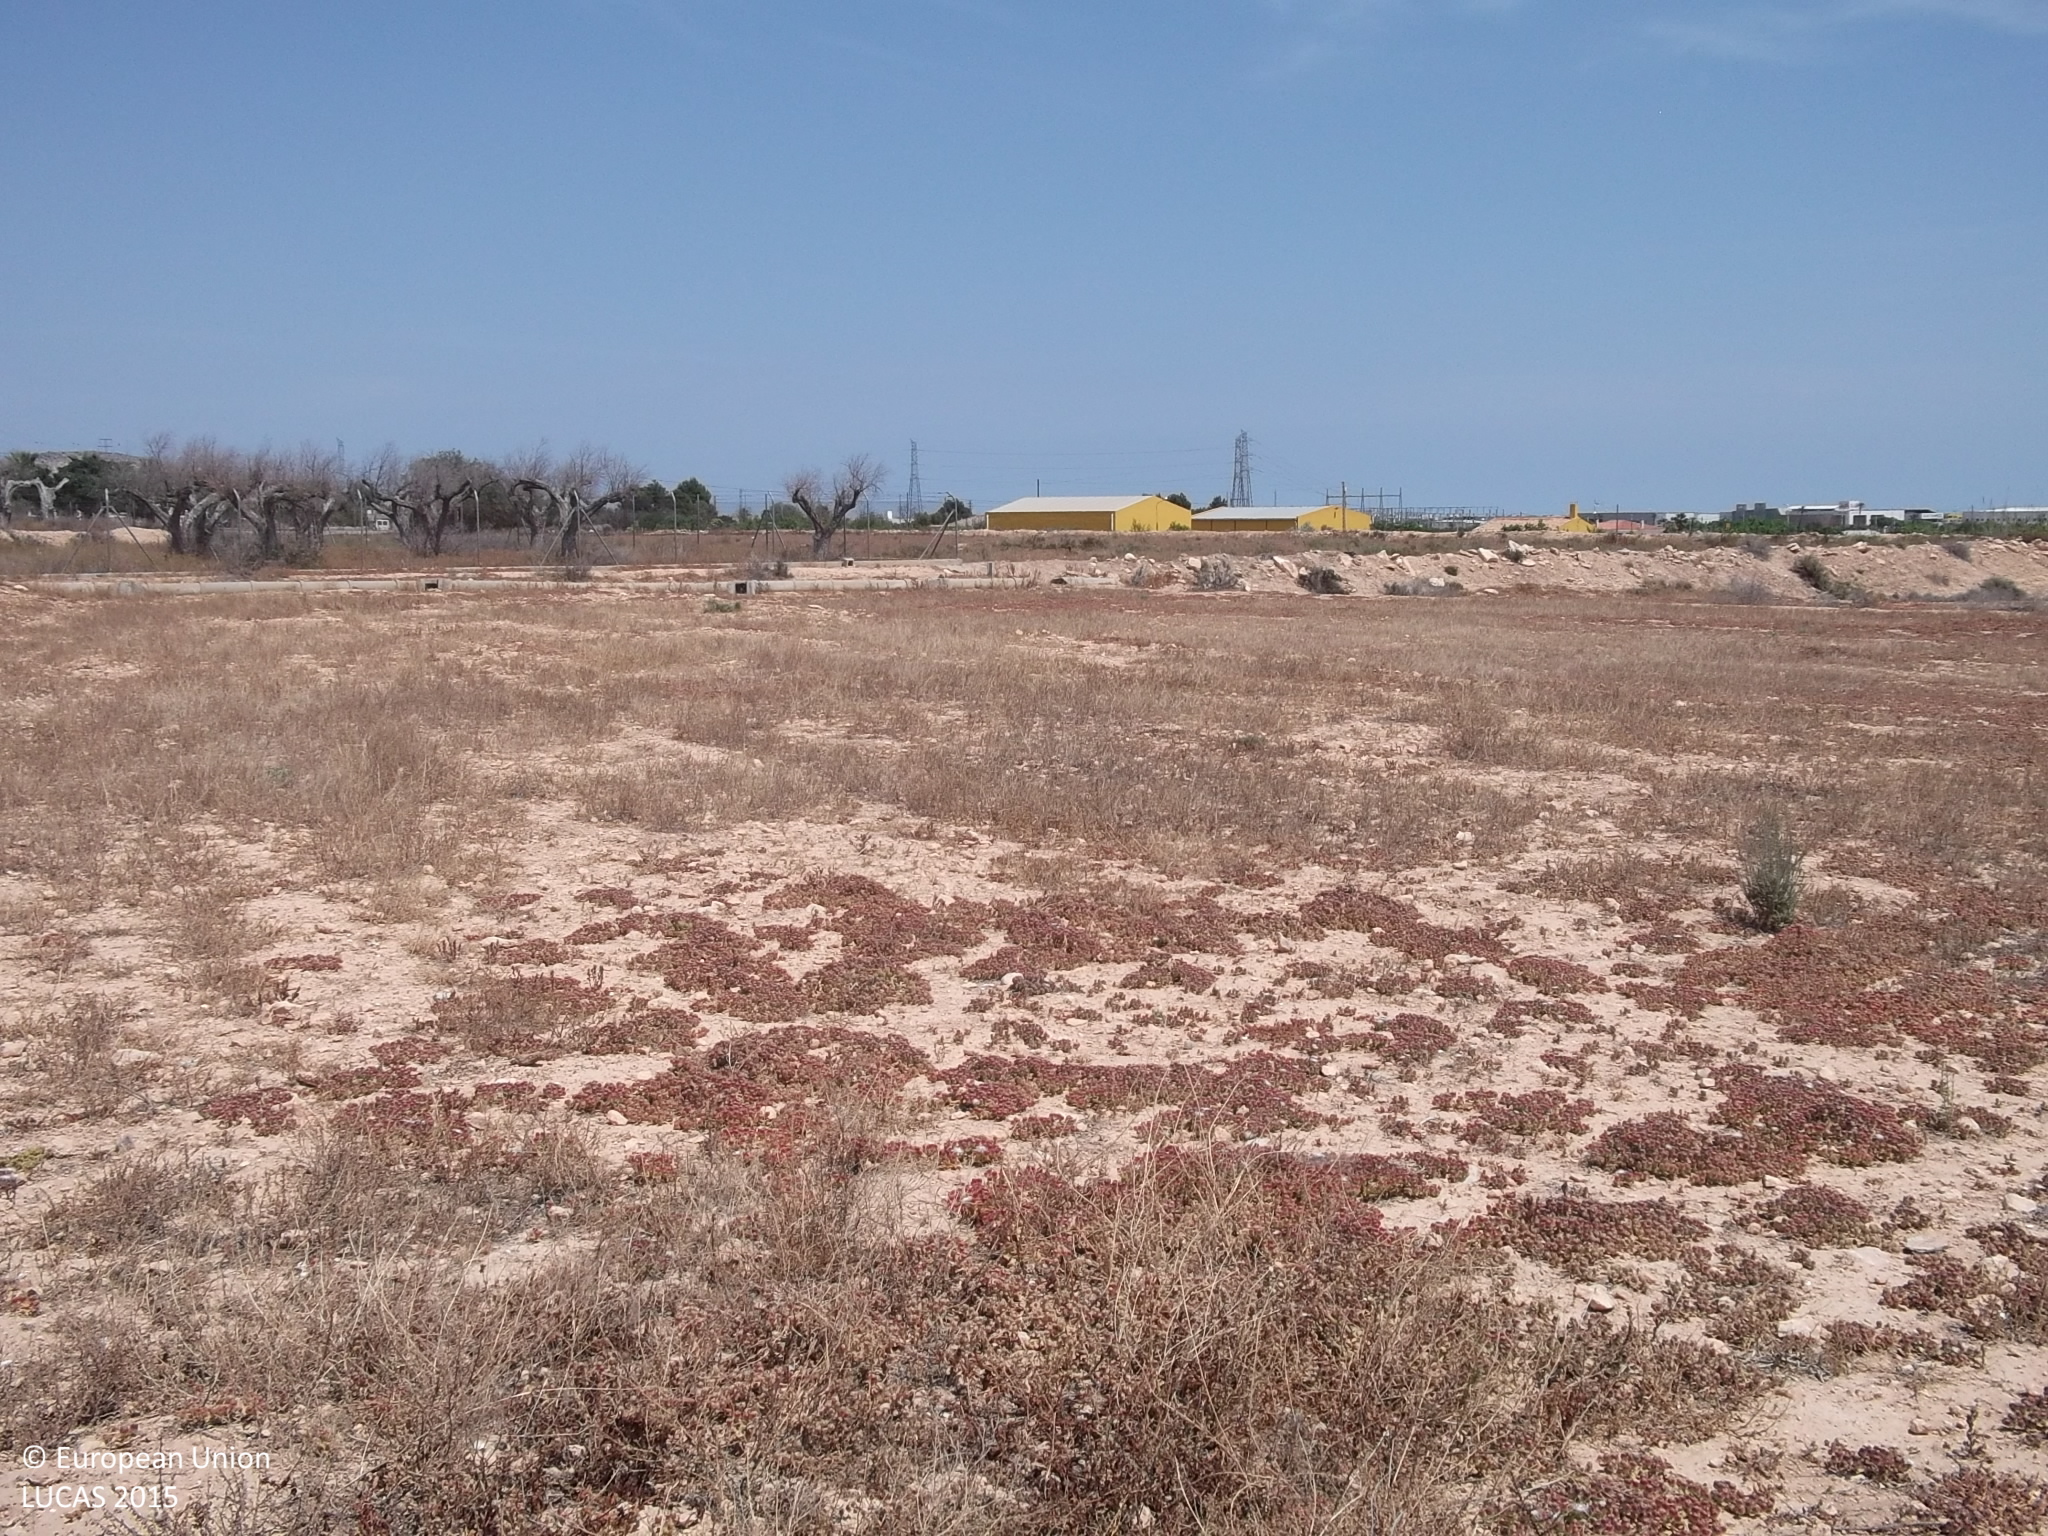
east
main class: Grassland
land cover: Grassland without tree/shrub cover
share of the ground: 50 - 75 %
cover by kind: herbaceous plants 60 %, unconsolidated bare surface 40 %
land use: Abandoned areas
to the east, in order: Grassland without tree/shrub cover; Grass margins; Fences; Olive groves; Fences; Grassland without tree/shrub cover; Grass margins; Shrubland without tree cover; Olive groves; Tracks; Shrubland without tree cover; Tracks; Nuts trees; Ditches and canals; Electric lines; Nuts trees
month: May
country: ES
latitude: 38.3010
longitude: -0.6314
